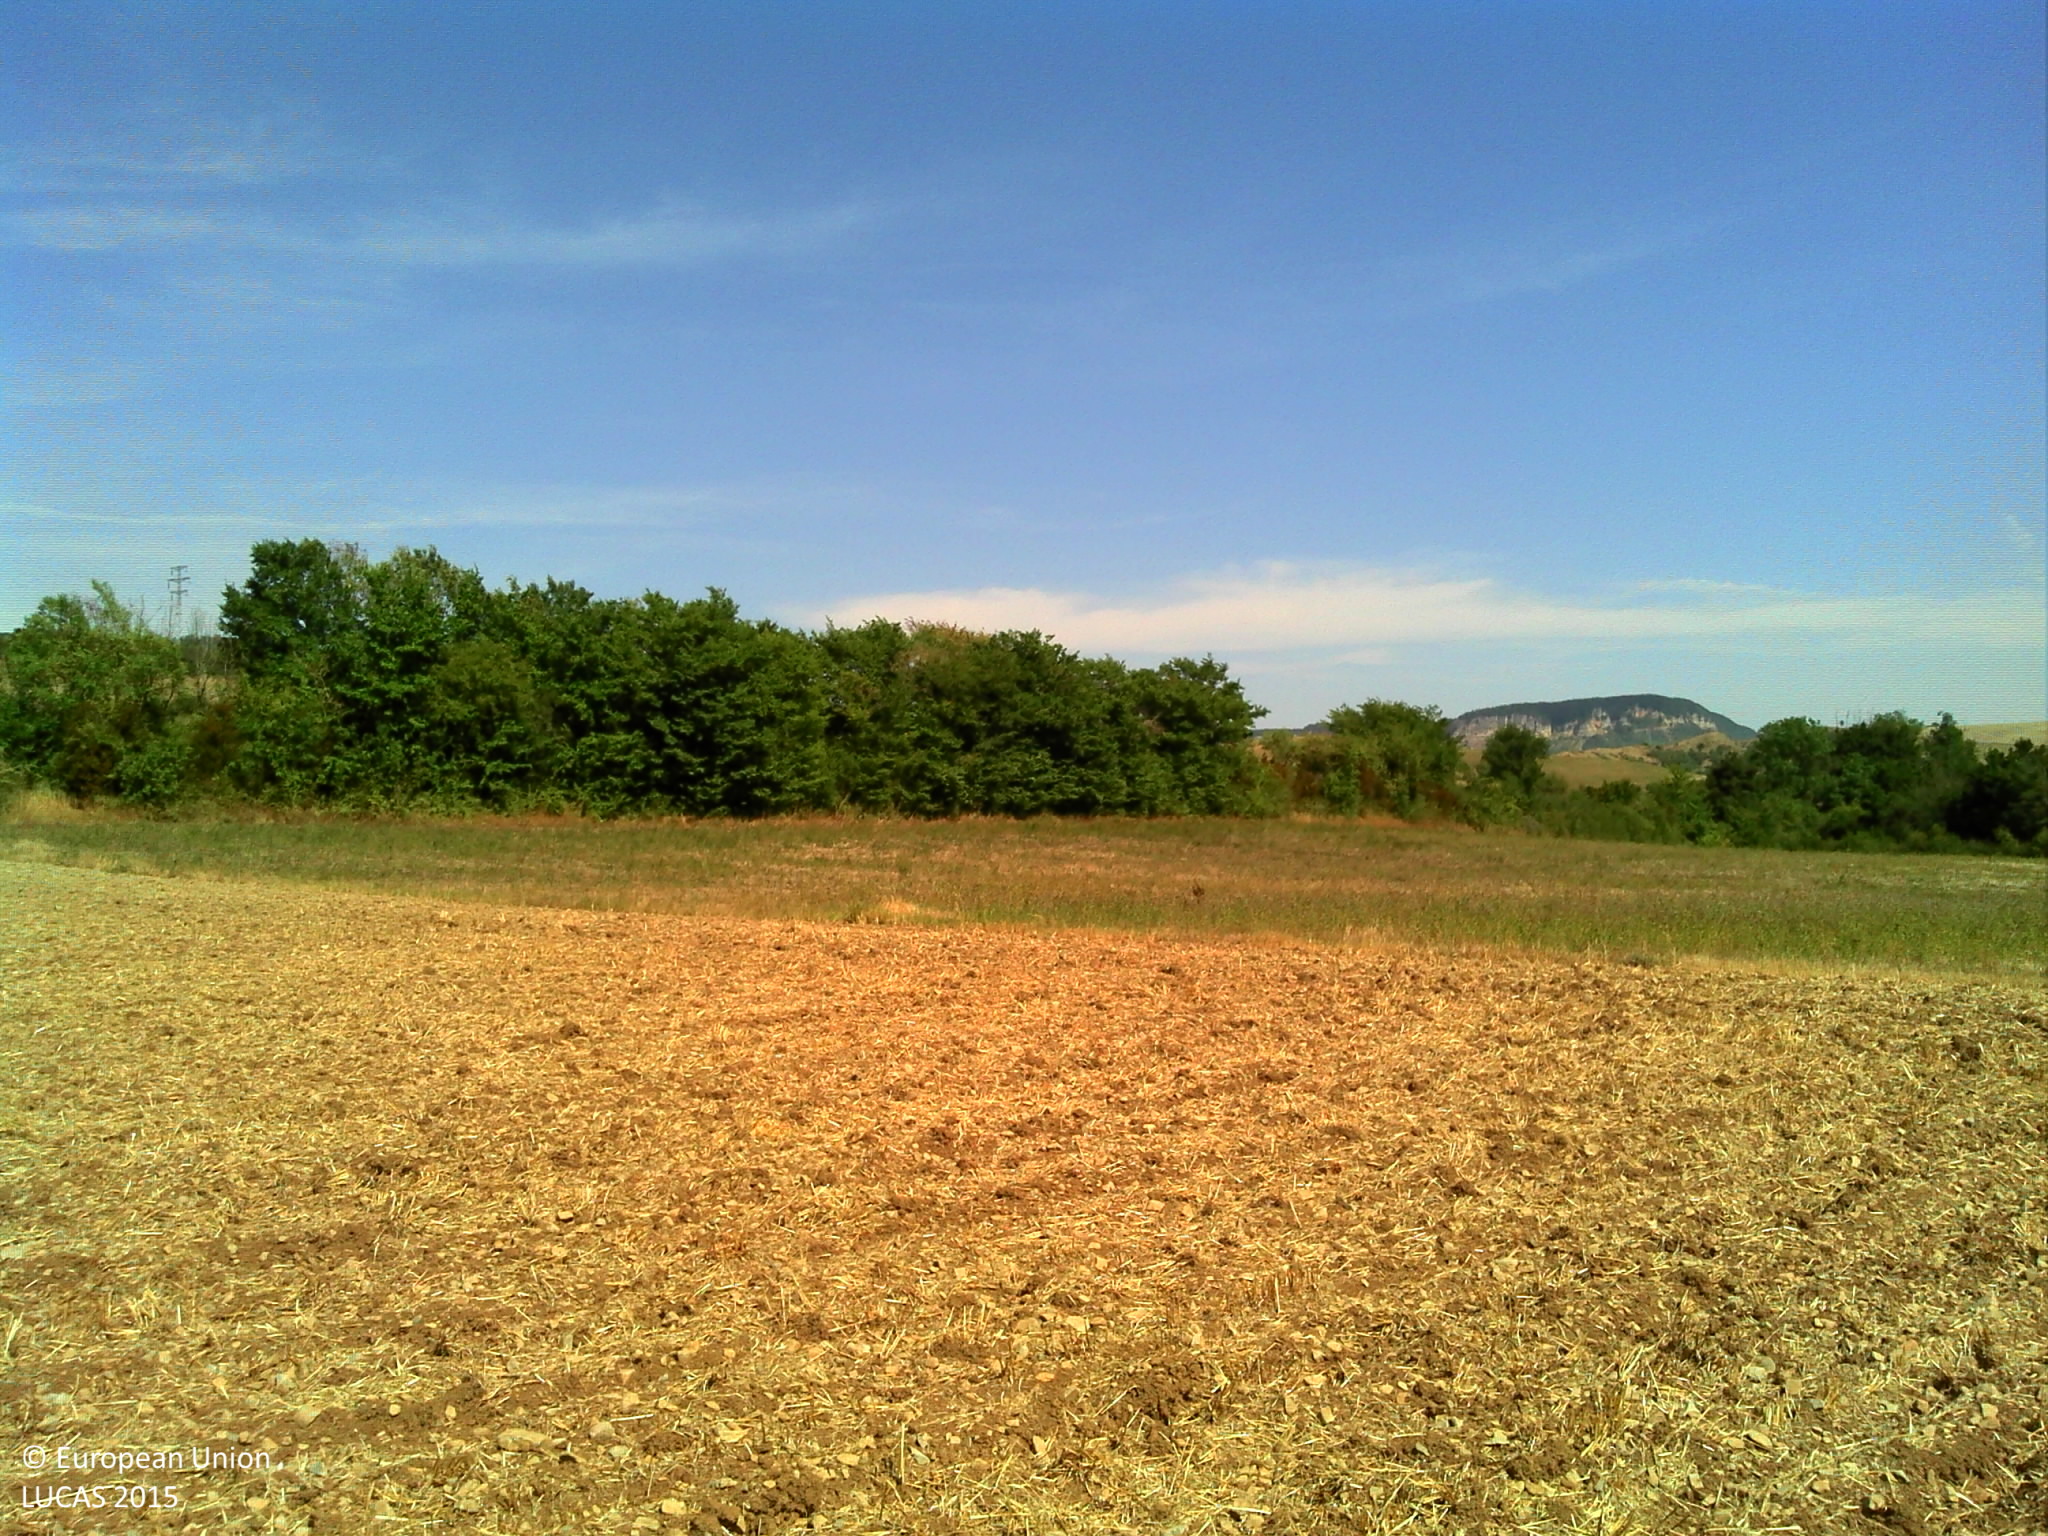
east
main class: Cropland
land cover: Barley
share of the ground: > 75 %
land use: Agriculture (excluding fallow land and kitchen gardens)
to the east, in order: Barley; Lucerne; Abandoned hedges; Tracks; Abandoned hedges; Fences; Temporary grasslands; Fences; Temporary grasslands; Abandoned hedges; Grassland without tree/shrub cover
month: August
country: FR
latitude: 43.9342
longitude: 3.0180
